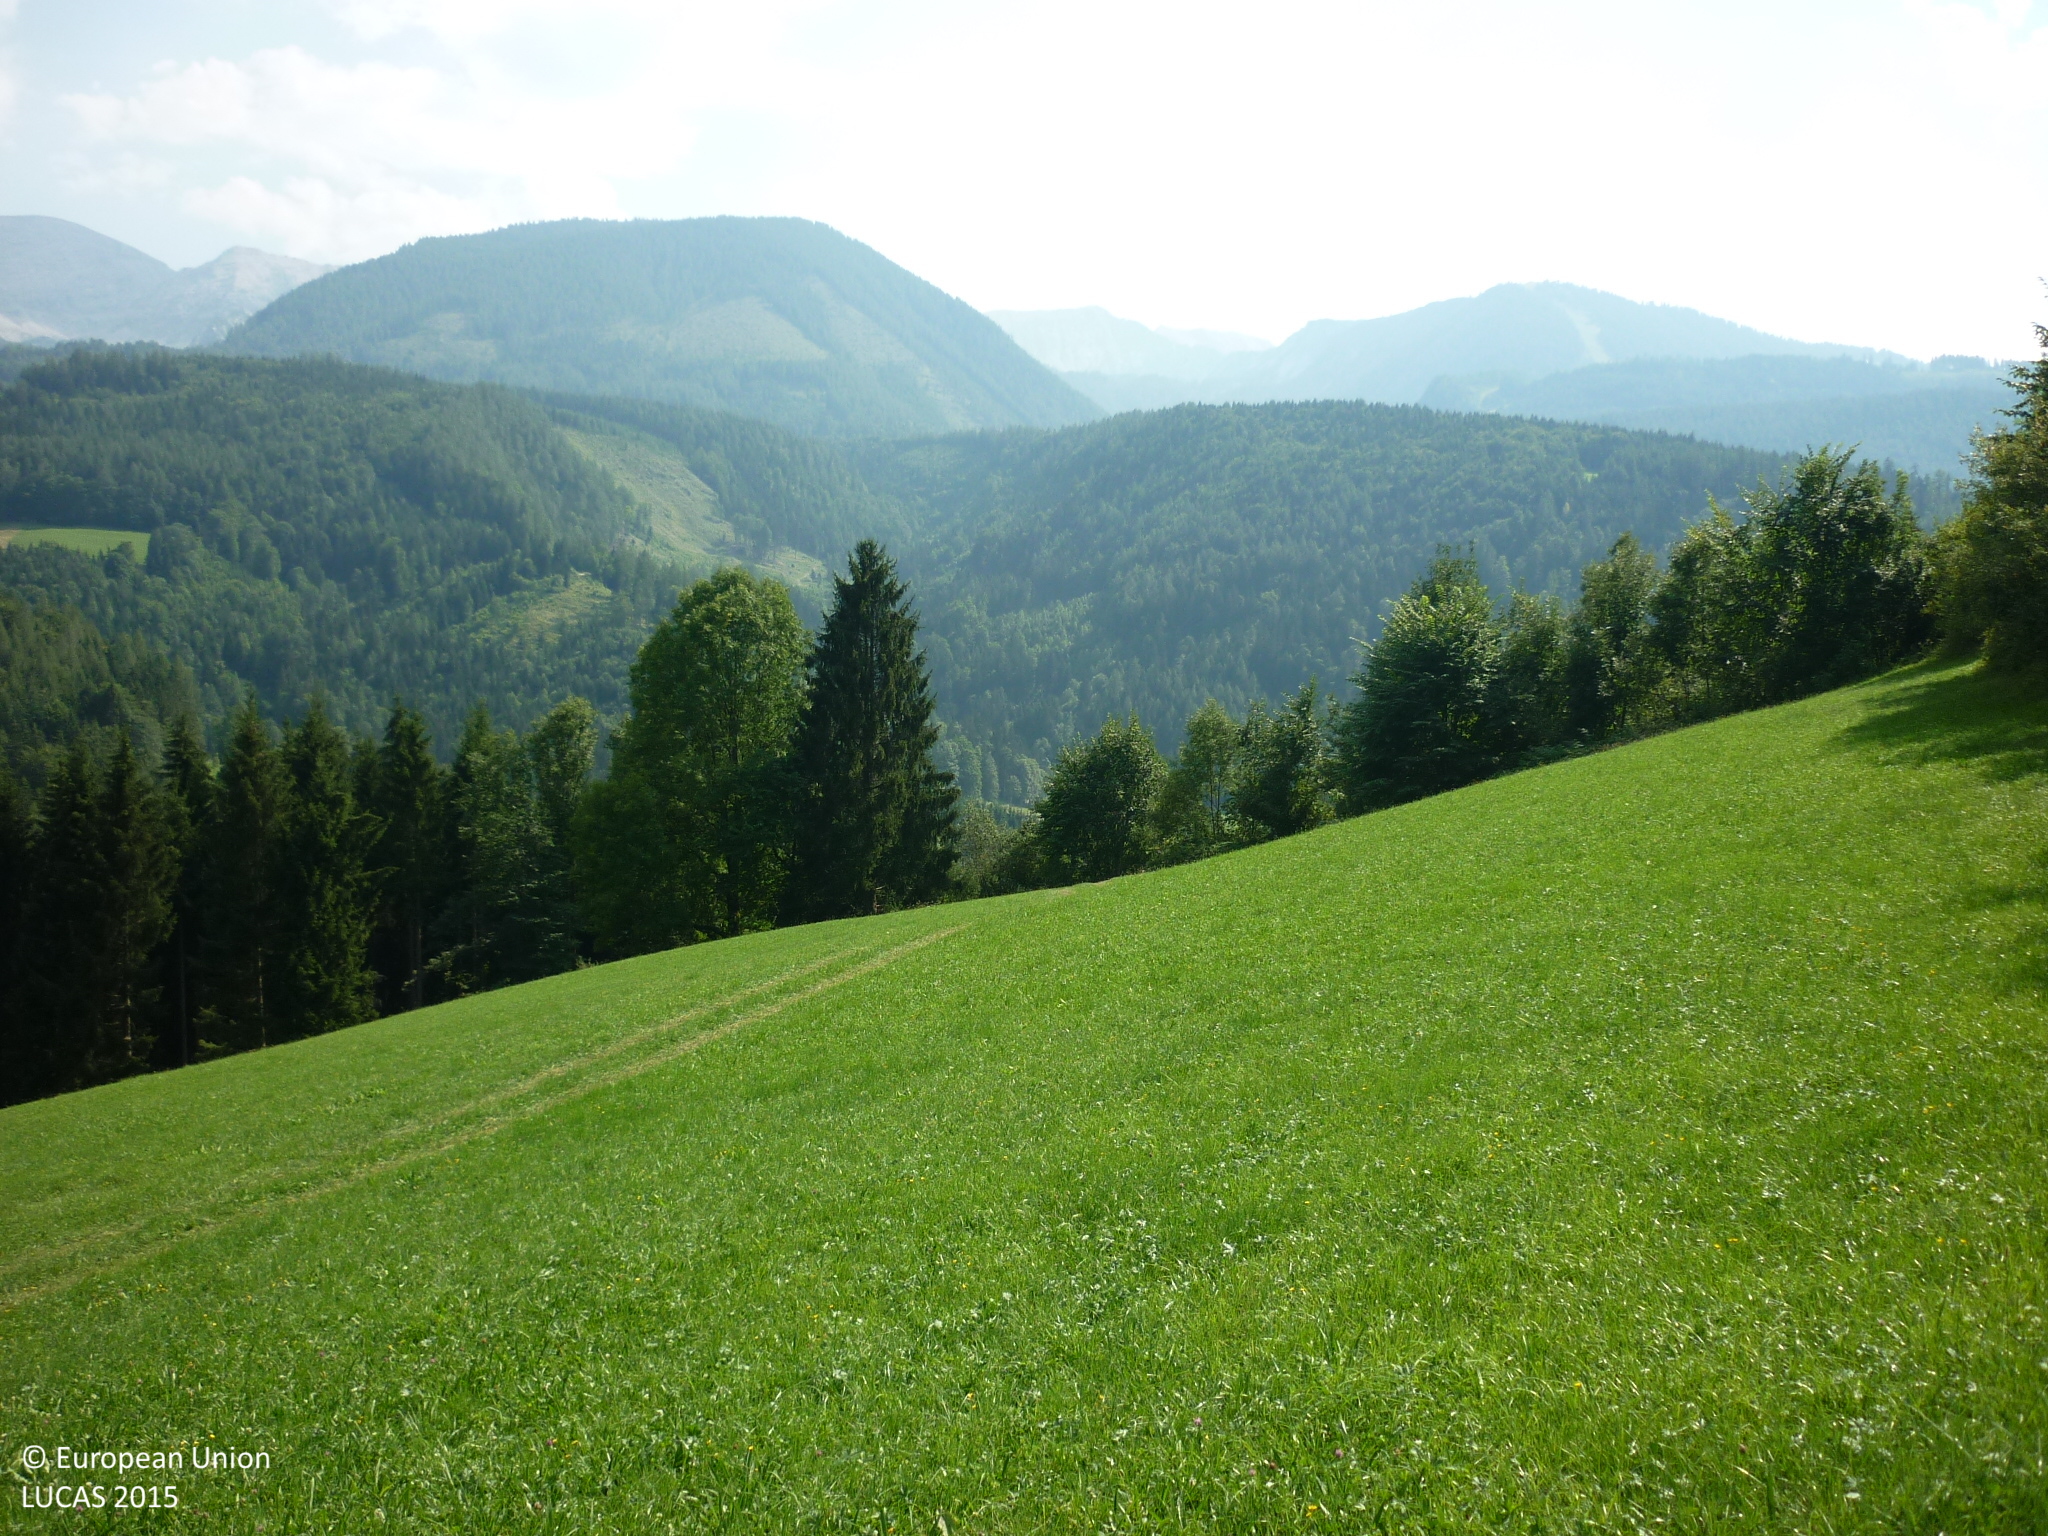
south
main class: Grassland
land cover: Grassland without tree/shrub cover
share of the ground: > 75 %
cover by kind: herbaceous plants 100 %
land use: Agriculture (excluding fallow land and kitchen gardens)
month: August
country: AT
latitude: 47.7112
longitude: 14.1977
